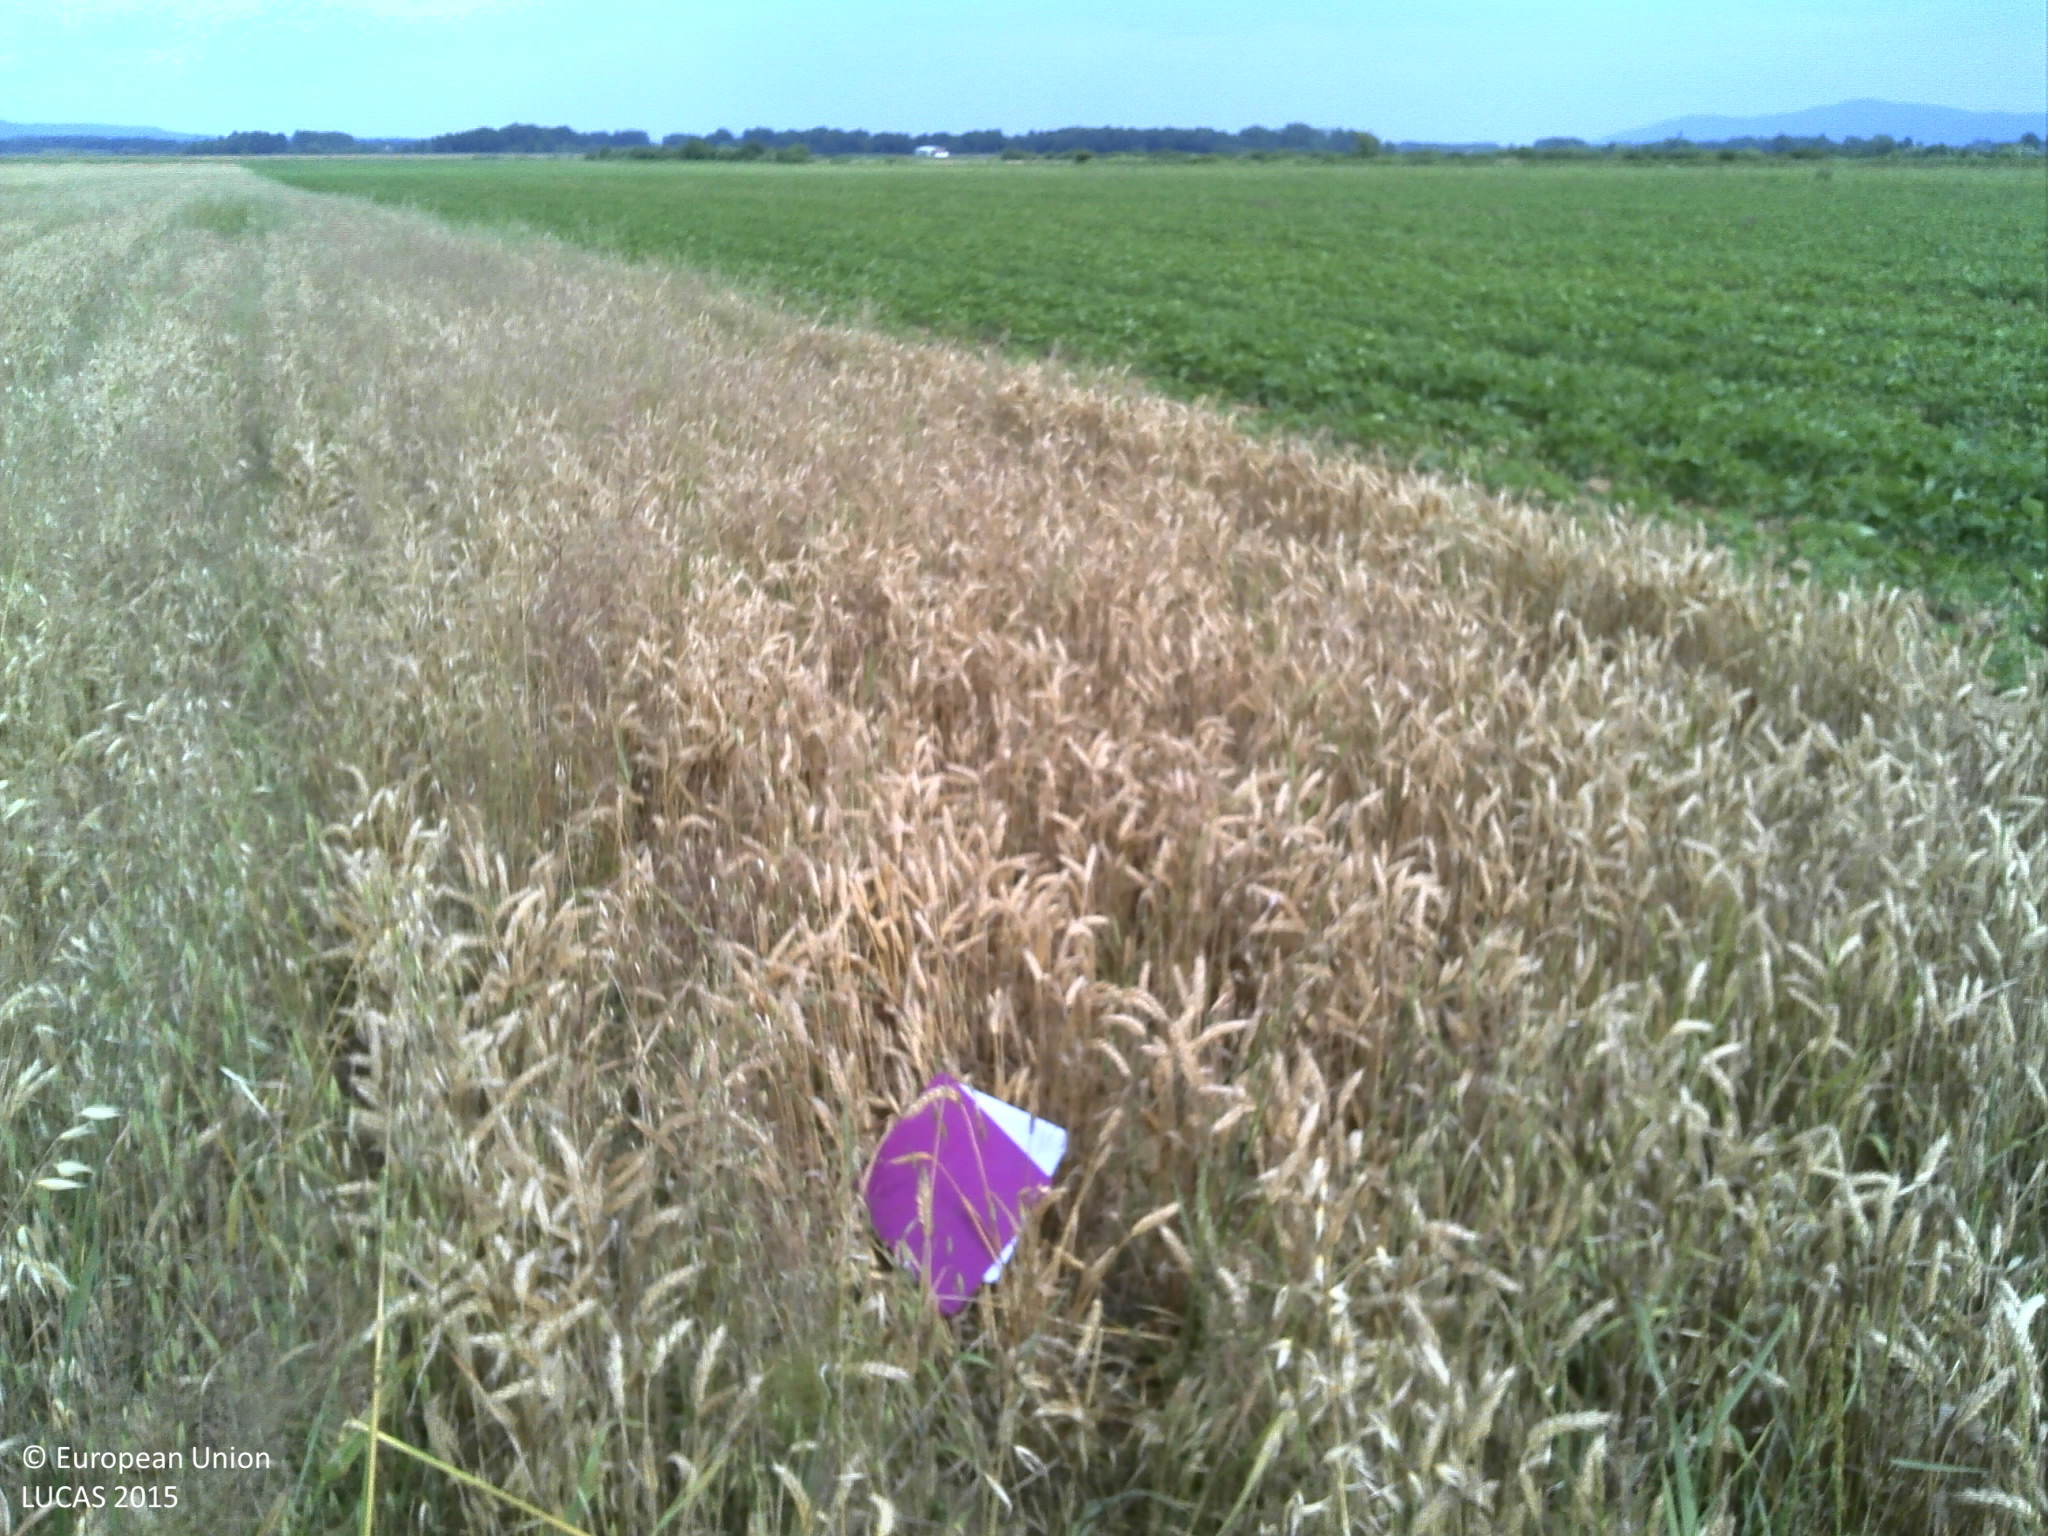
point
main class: Cropland
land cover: Common wheat
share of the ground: > 75 %
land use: Agriculture (excluding fallow land and kitchen gardens)
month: June
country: HR
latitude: 45.2246
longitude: 17.4251
